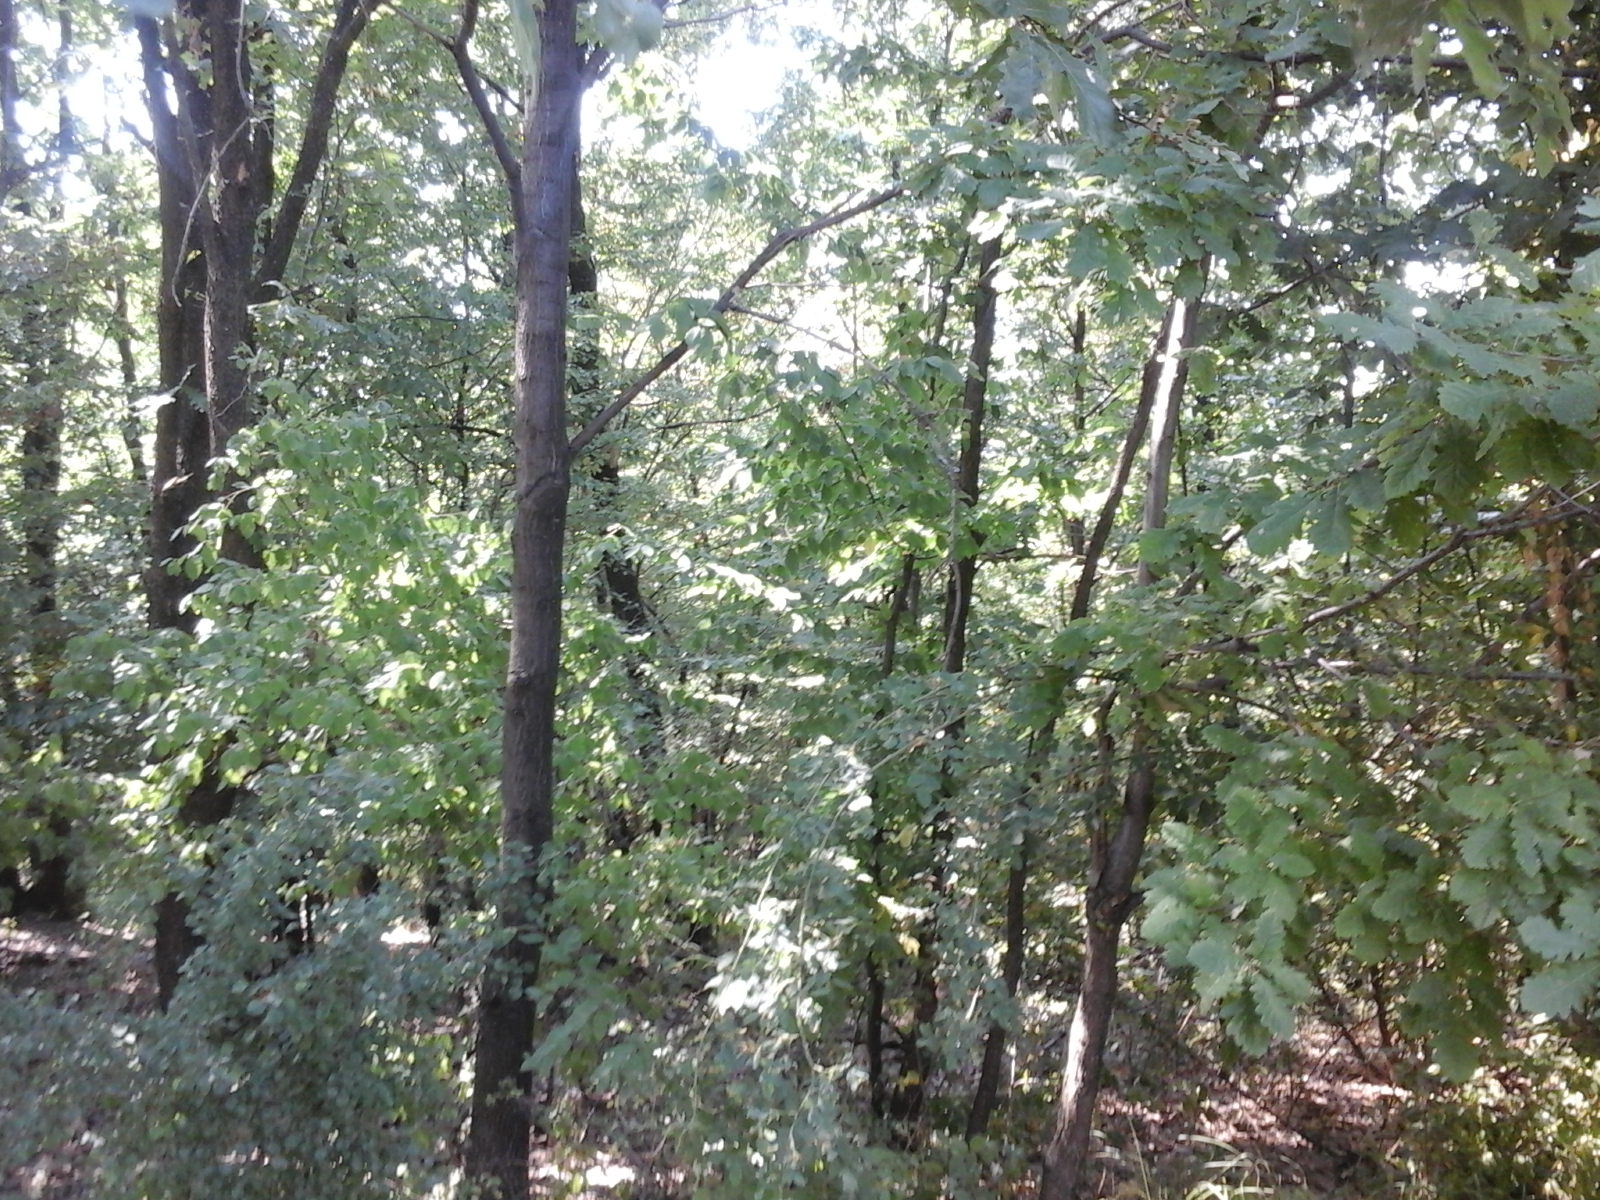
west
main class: Woodland
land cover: Broadleaved woodland
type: acidophilous oak and oak-birch forest
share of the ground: > 75 %
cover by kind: broadleaved forest trees 100 %
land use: Forestry
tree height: > 5 m
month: August
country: RO
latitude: 44.8899
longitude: 23.9025
